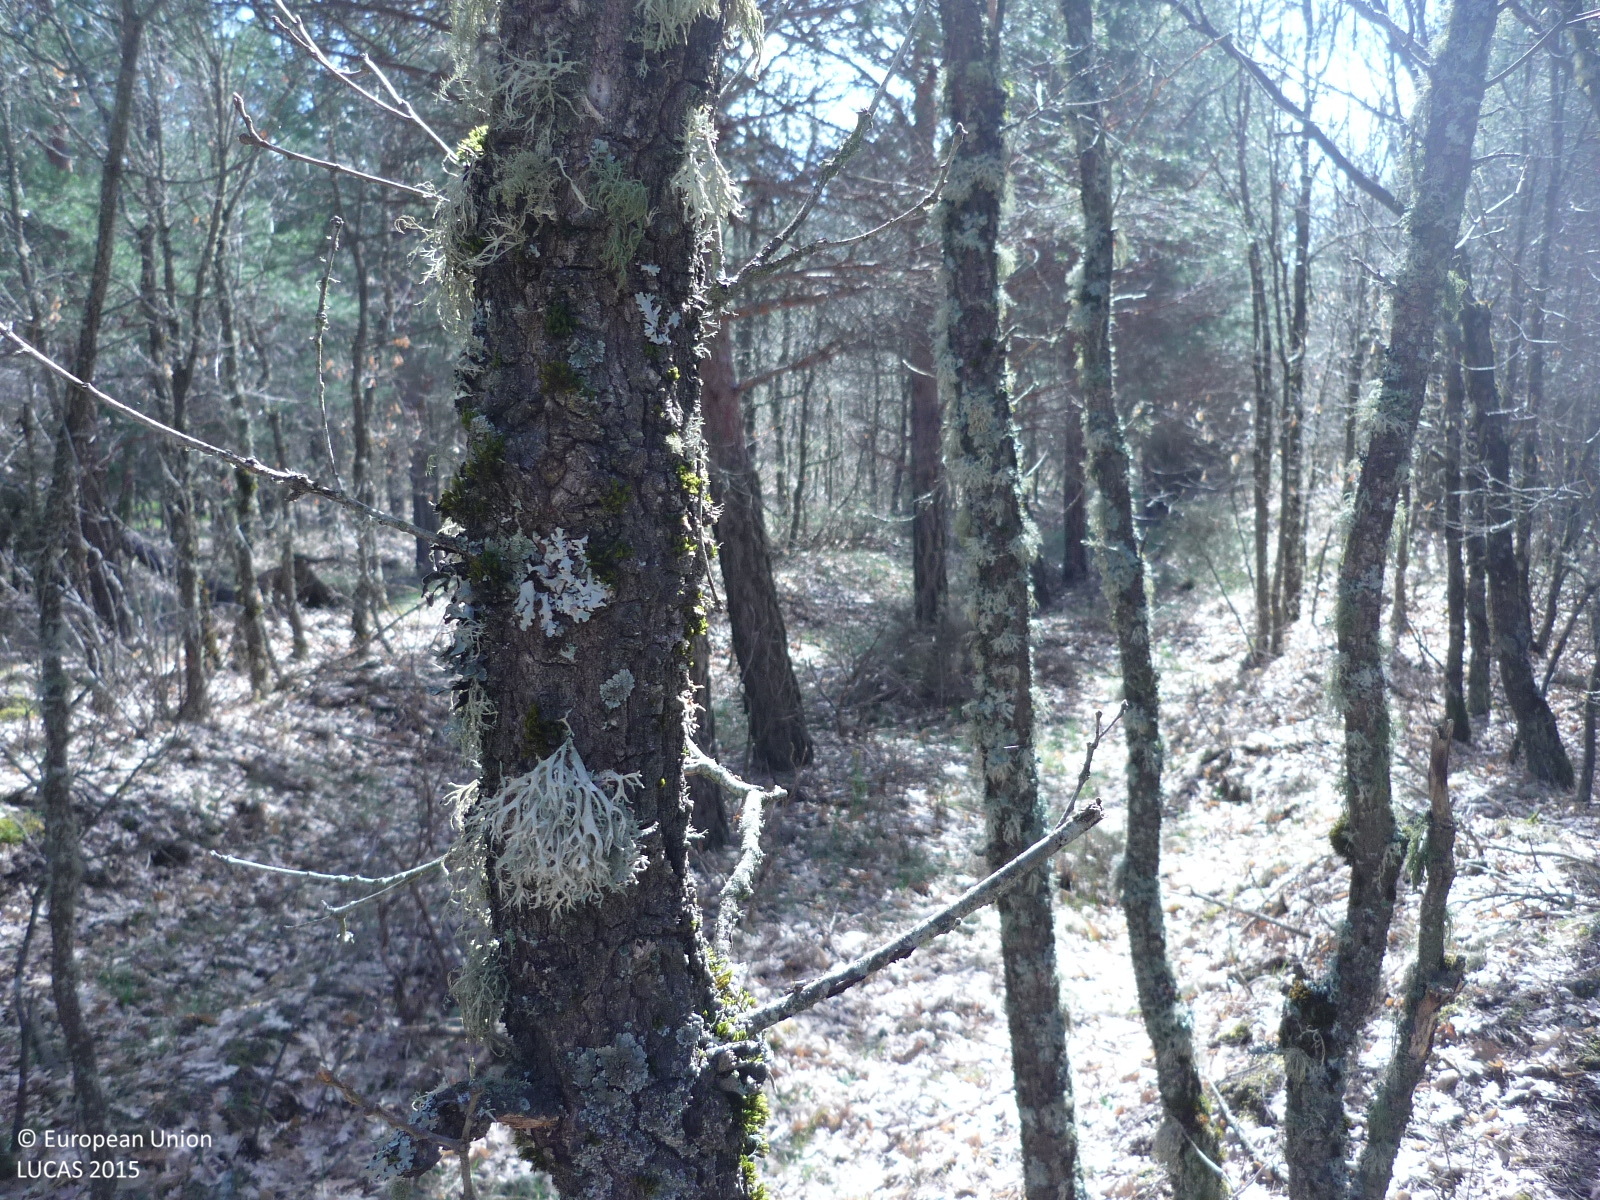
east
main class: Woodland
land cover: Pine dominated mixed woodland
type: coniferous forest of the mediterranean region
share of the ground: > 75 %
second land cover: Grassland without tree/shrub cover
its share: 10 - 25 %
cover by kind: coniferous forest trees 50 %, broadleaved forest trees 45 %, herbaceous plants 5 %
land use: Forestry
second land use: Agriculture (excluding fallow land and kitchen gardens)
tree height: > 5 m
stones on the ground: 10 - 25 %
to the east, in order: Pine dominated mixed woodland; Grassland without tree/shrub cover; Pine dominated mixed woodland
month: April
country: ES
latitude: 41.2670
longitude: -3.5223
